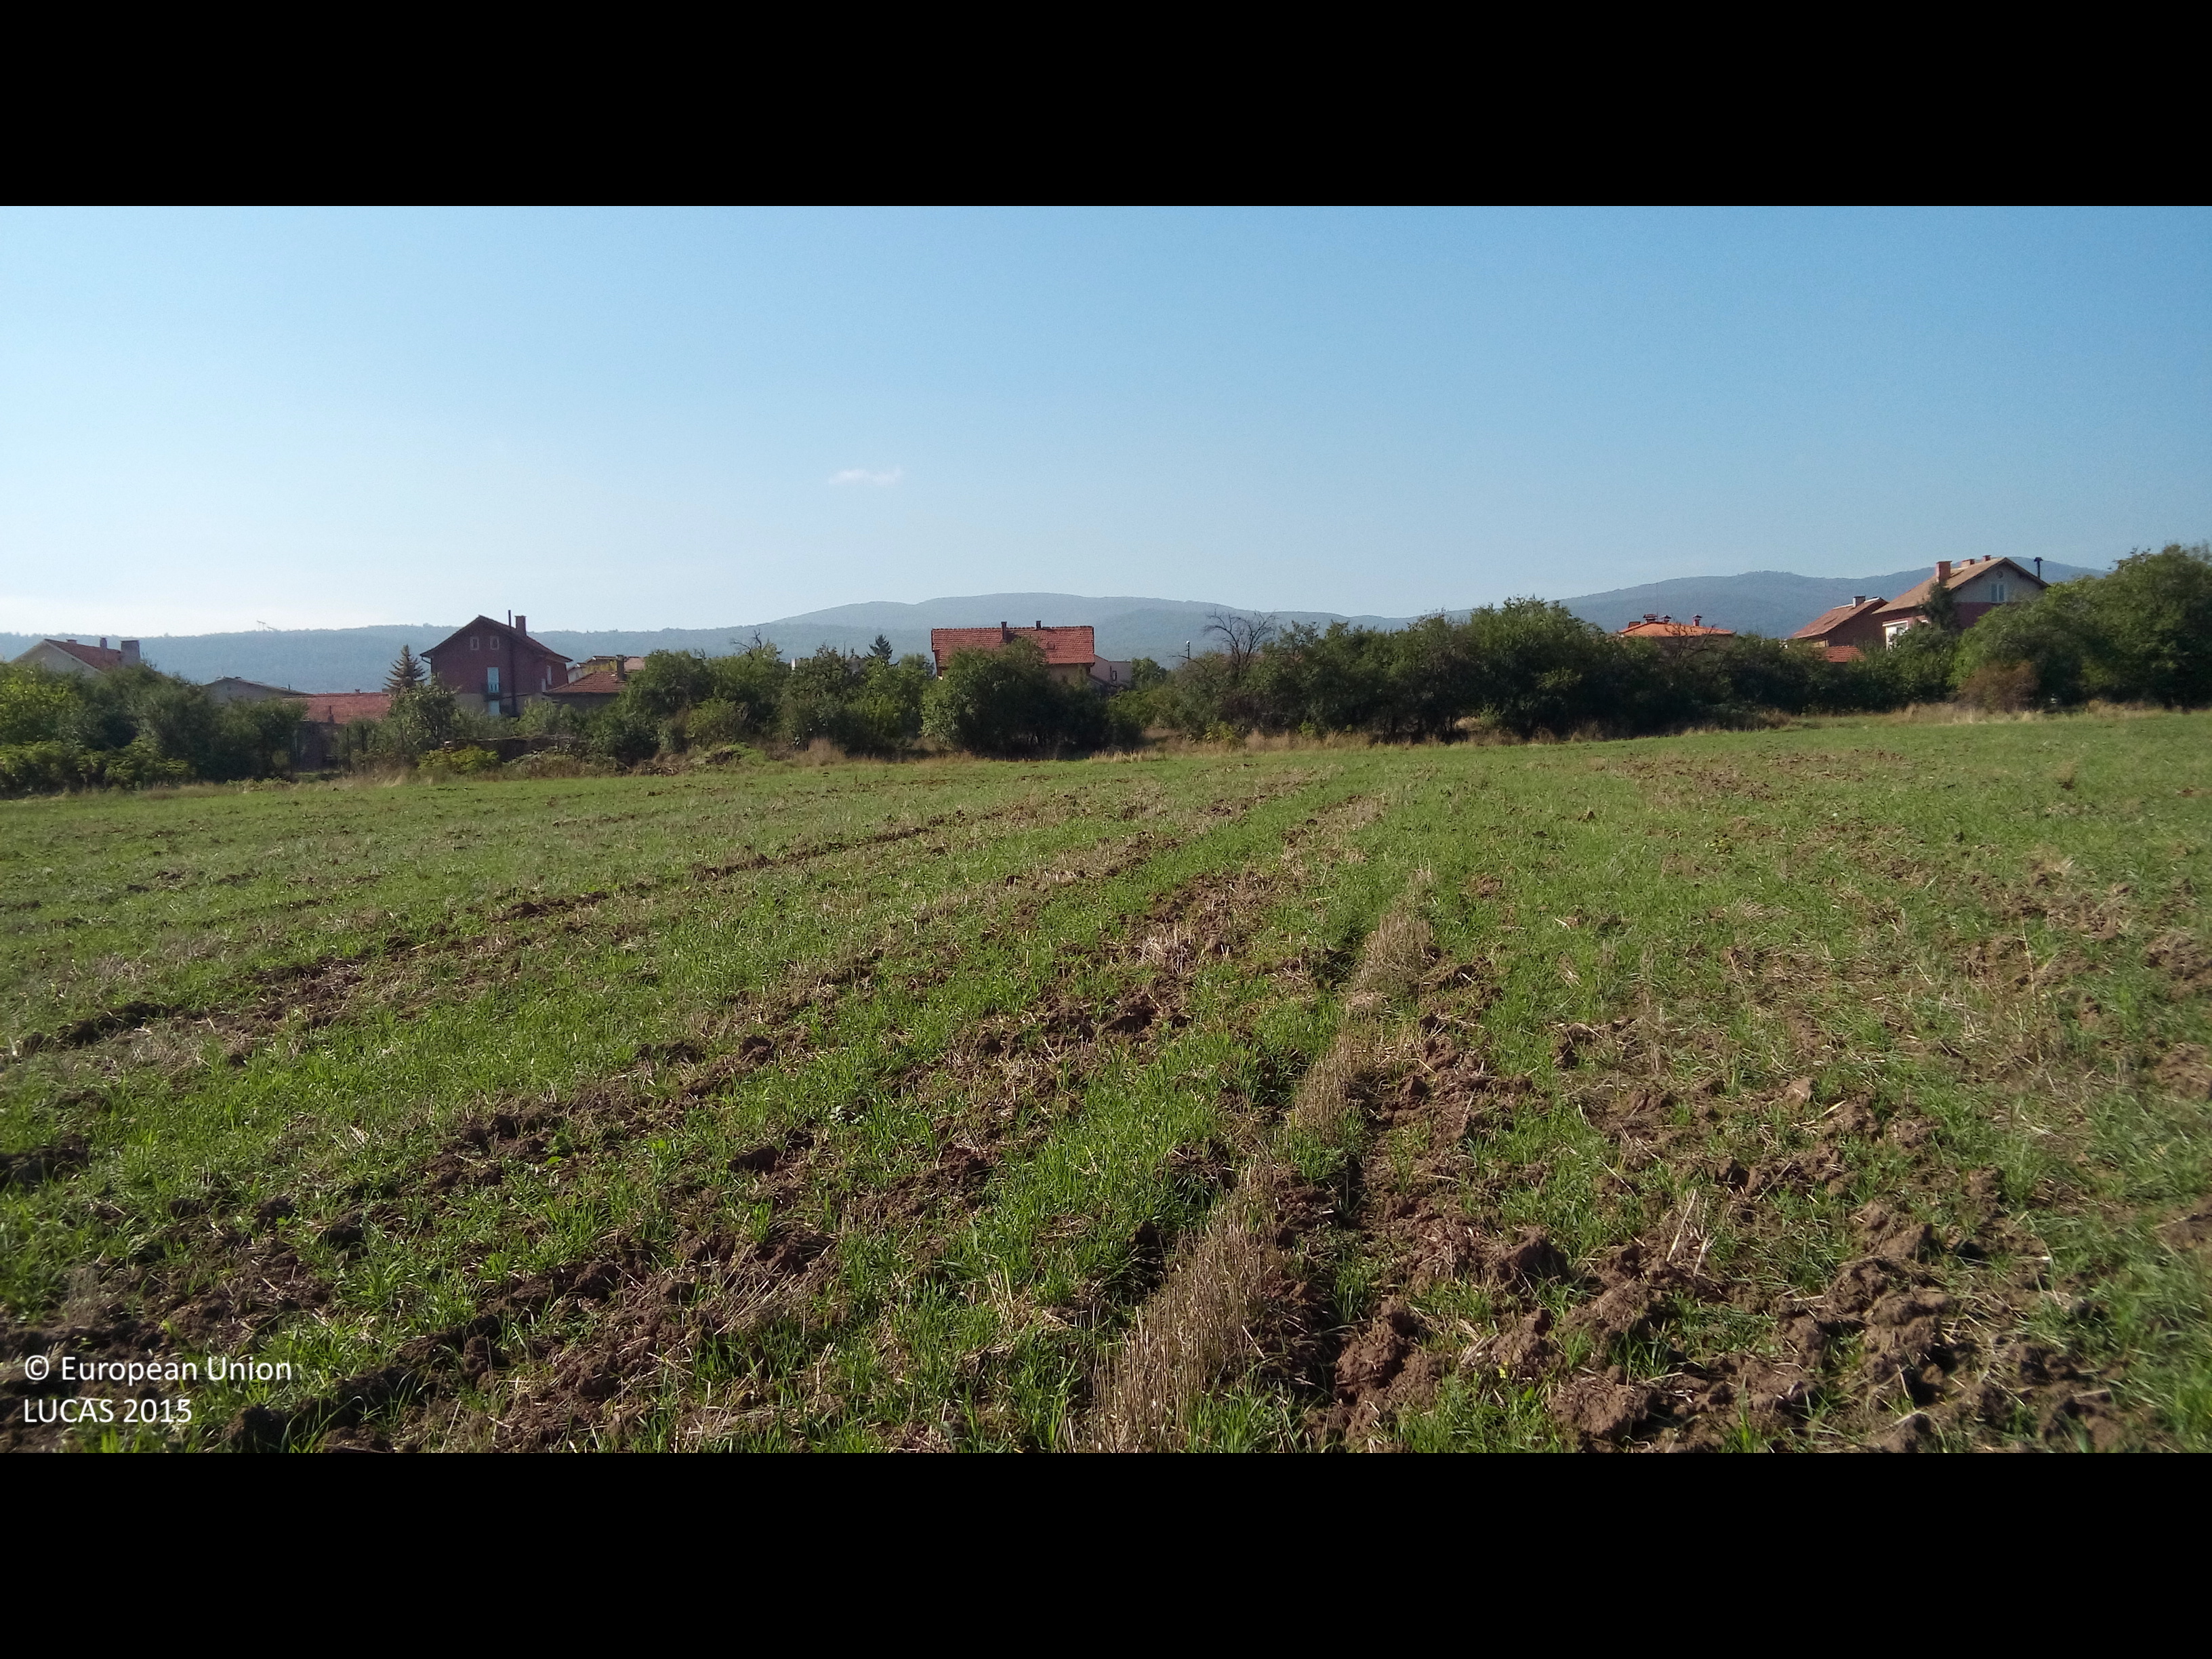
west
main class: Cropland
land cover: Common wheat
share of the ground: < 10 %
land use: Agriculture (excluding fallow land and kitchen gardens)
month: October
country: BG
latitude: 42.6090
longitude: 23.6047
